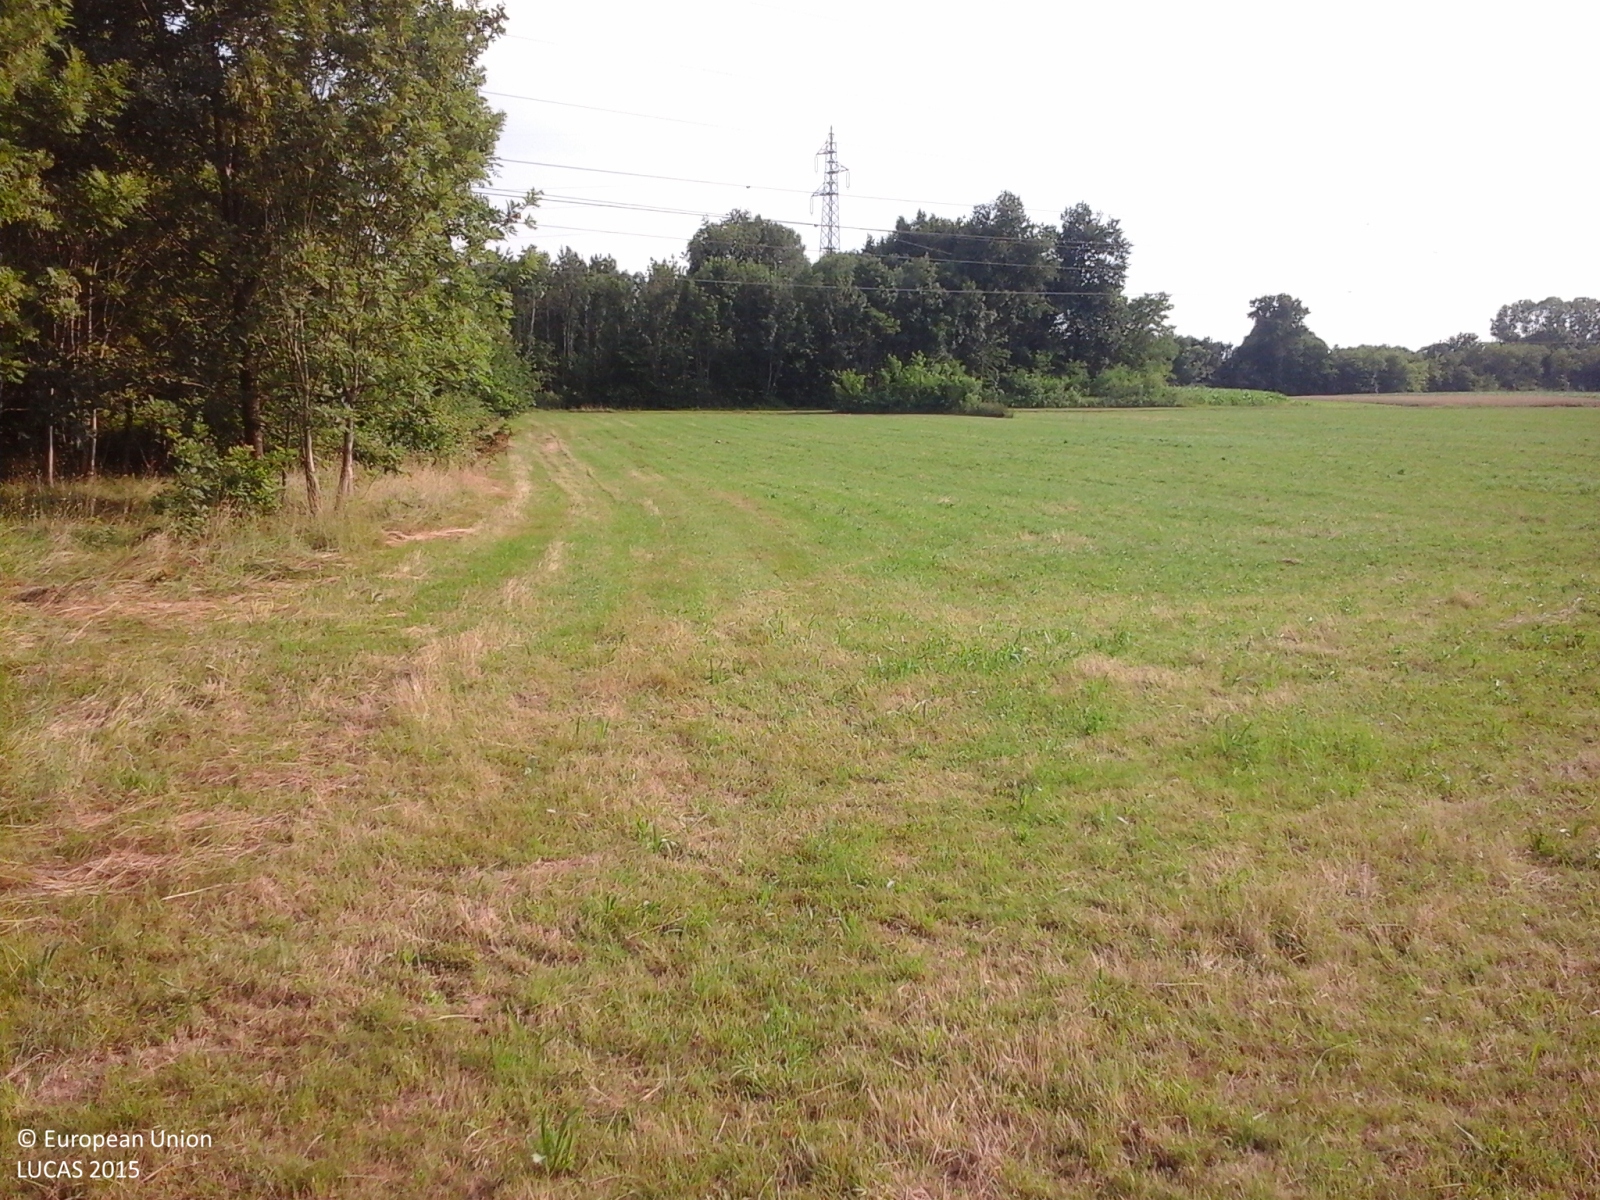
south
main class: Grassland
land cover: Grassland without tree/shrub cover
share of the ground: > 75 %
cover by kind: herbaceous plants 100 %
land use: Agriculture (excluding fallow land and kitchen gardens)
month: June
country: IT
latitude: 45.2100
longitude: 7.7502
